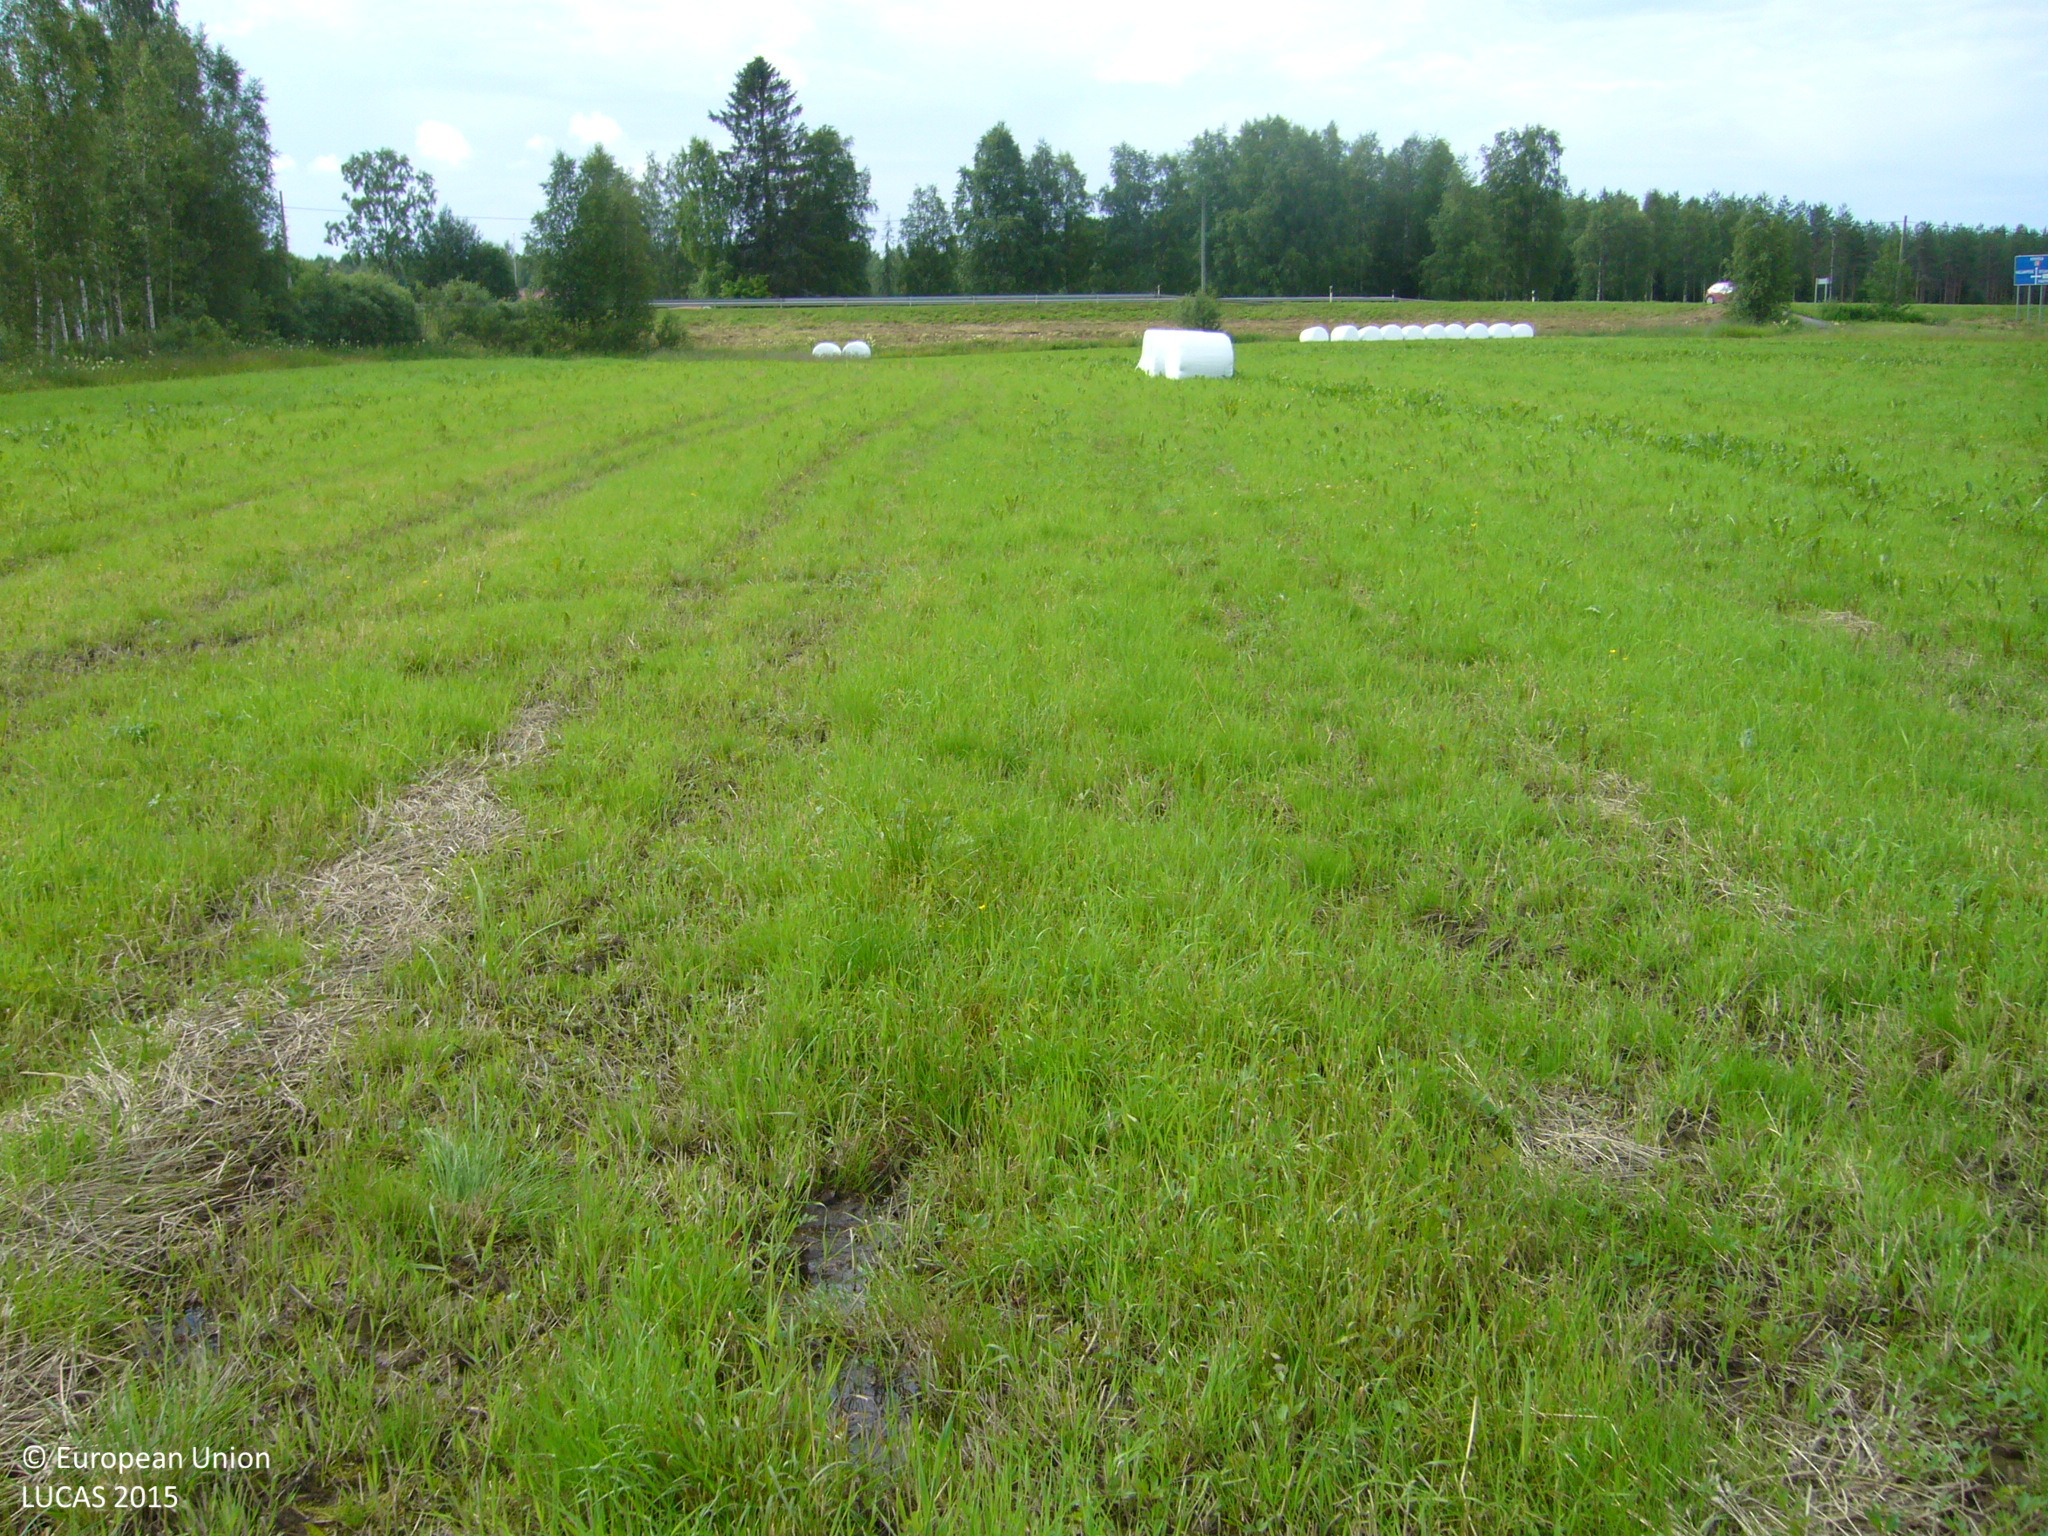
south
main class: Cropland
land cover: Temporary grasslands
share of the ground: > 75 %
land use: Agriculture (excluding fallow land and kitchen gardens)
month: July
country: FI
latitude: 63.9883
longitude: 25.6104
